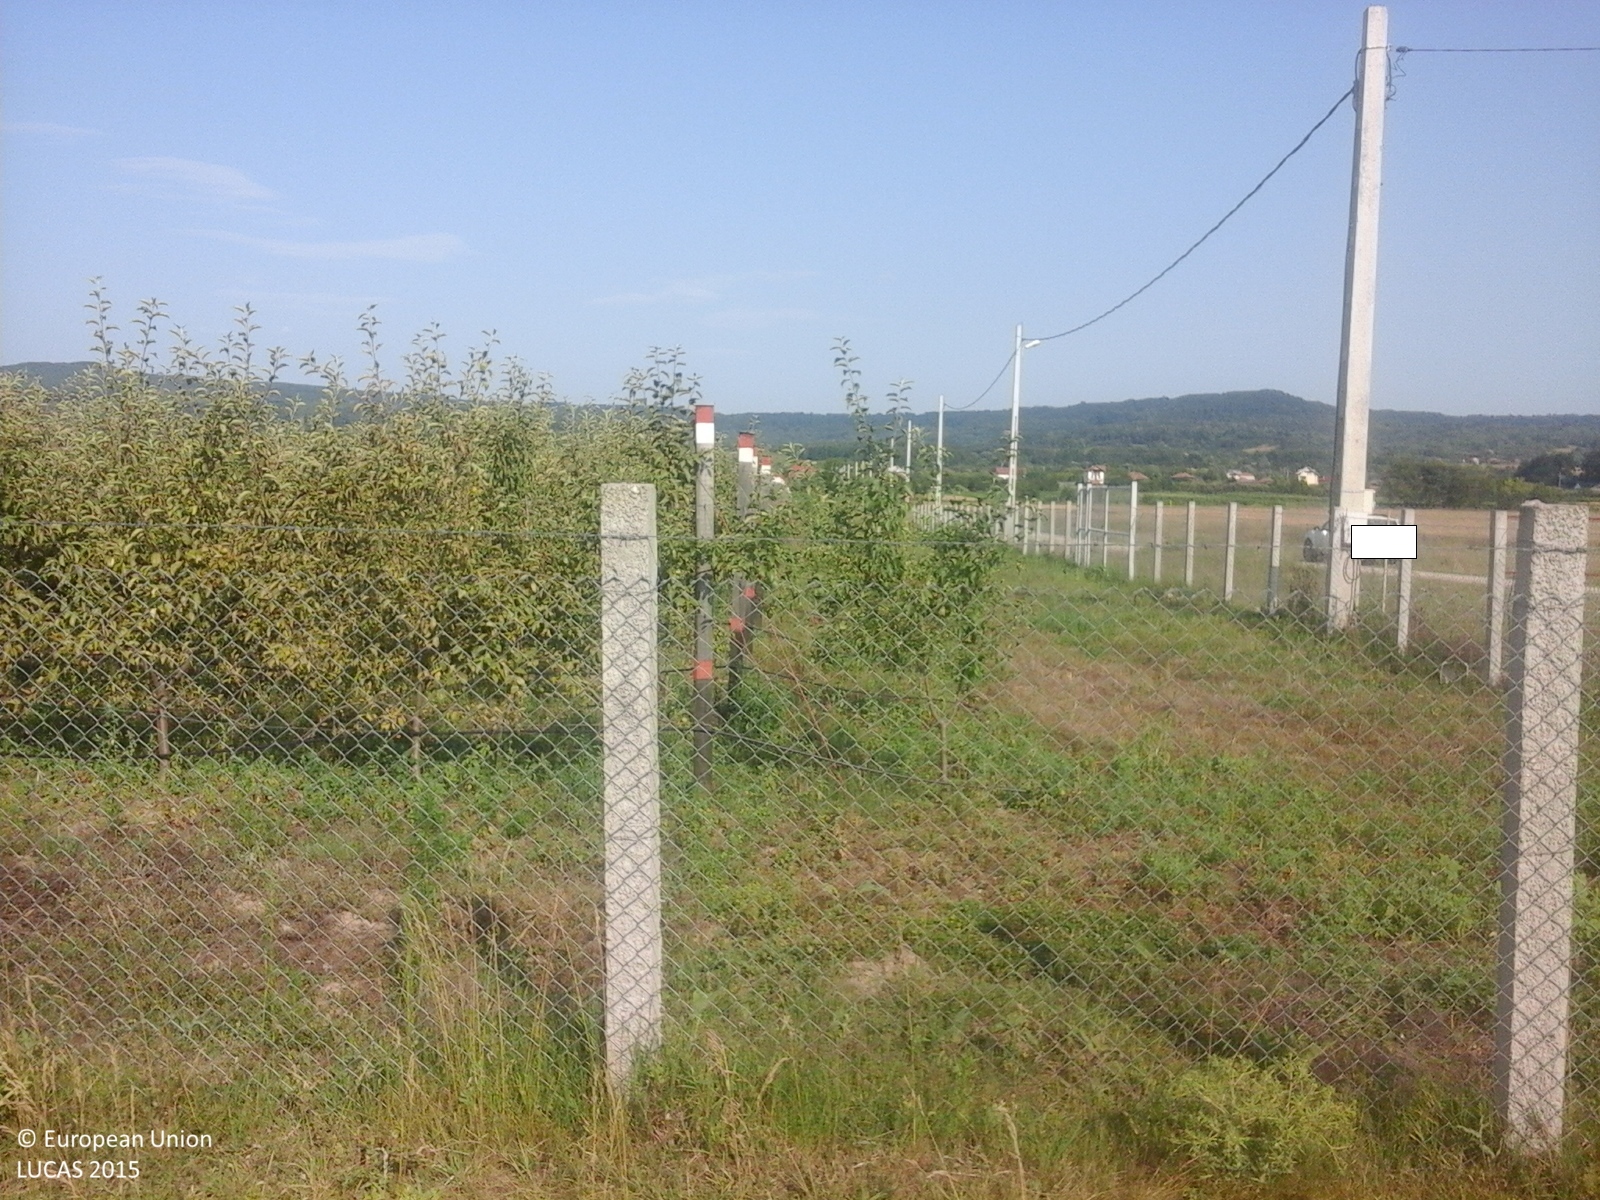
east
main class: Cropland
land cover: Apple fruit
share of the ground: > 75 %
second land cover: Spontaneously vegetated surfaces
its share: > 75 %
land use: Agriculture (excluding fallow land and kitchen gardens)
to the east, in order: Apple fruit; Spontaneously vegetated surfaces; Fences; Spontaneously vegetated surfaces; Fences; Maize; Common wheat; Maize
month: July
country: RO
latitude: 45.0442
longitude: 24.5109
